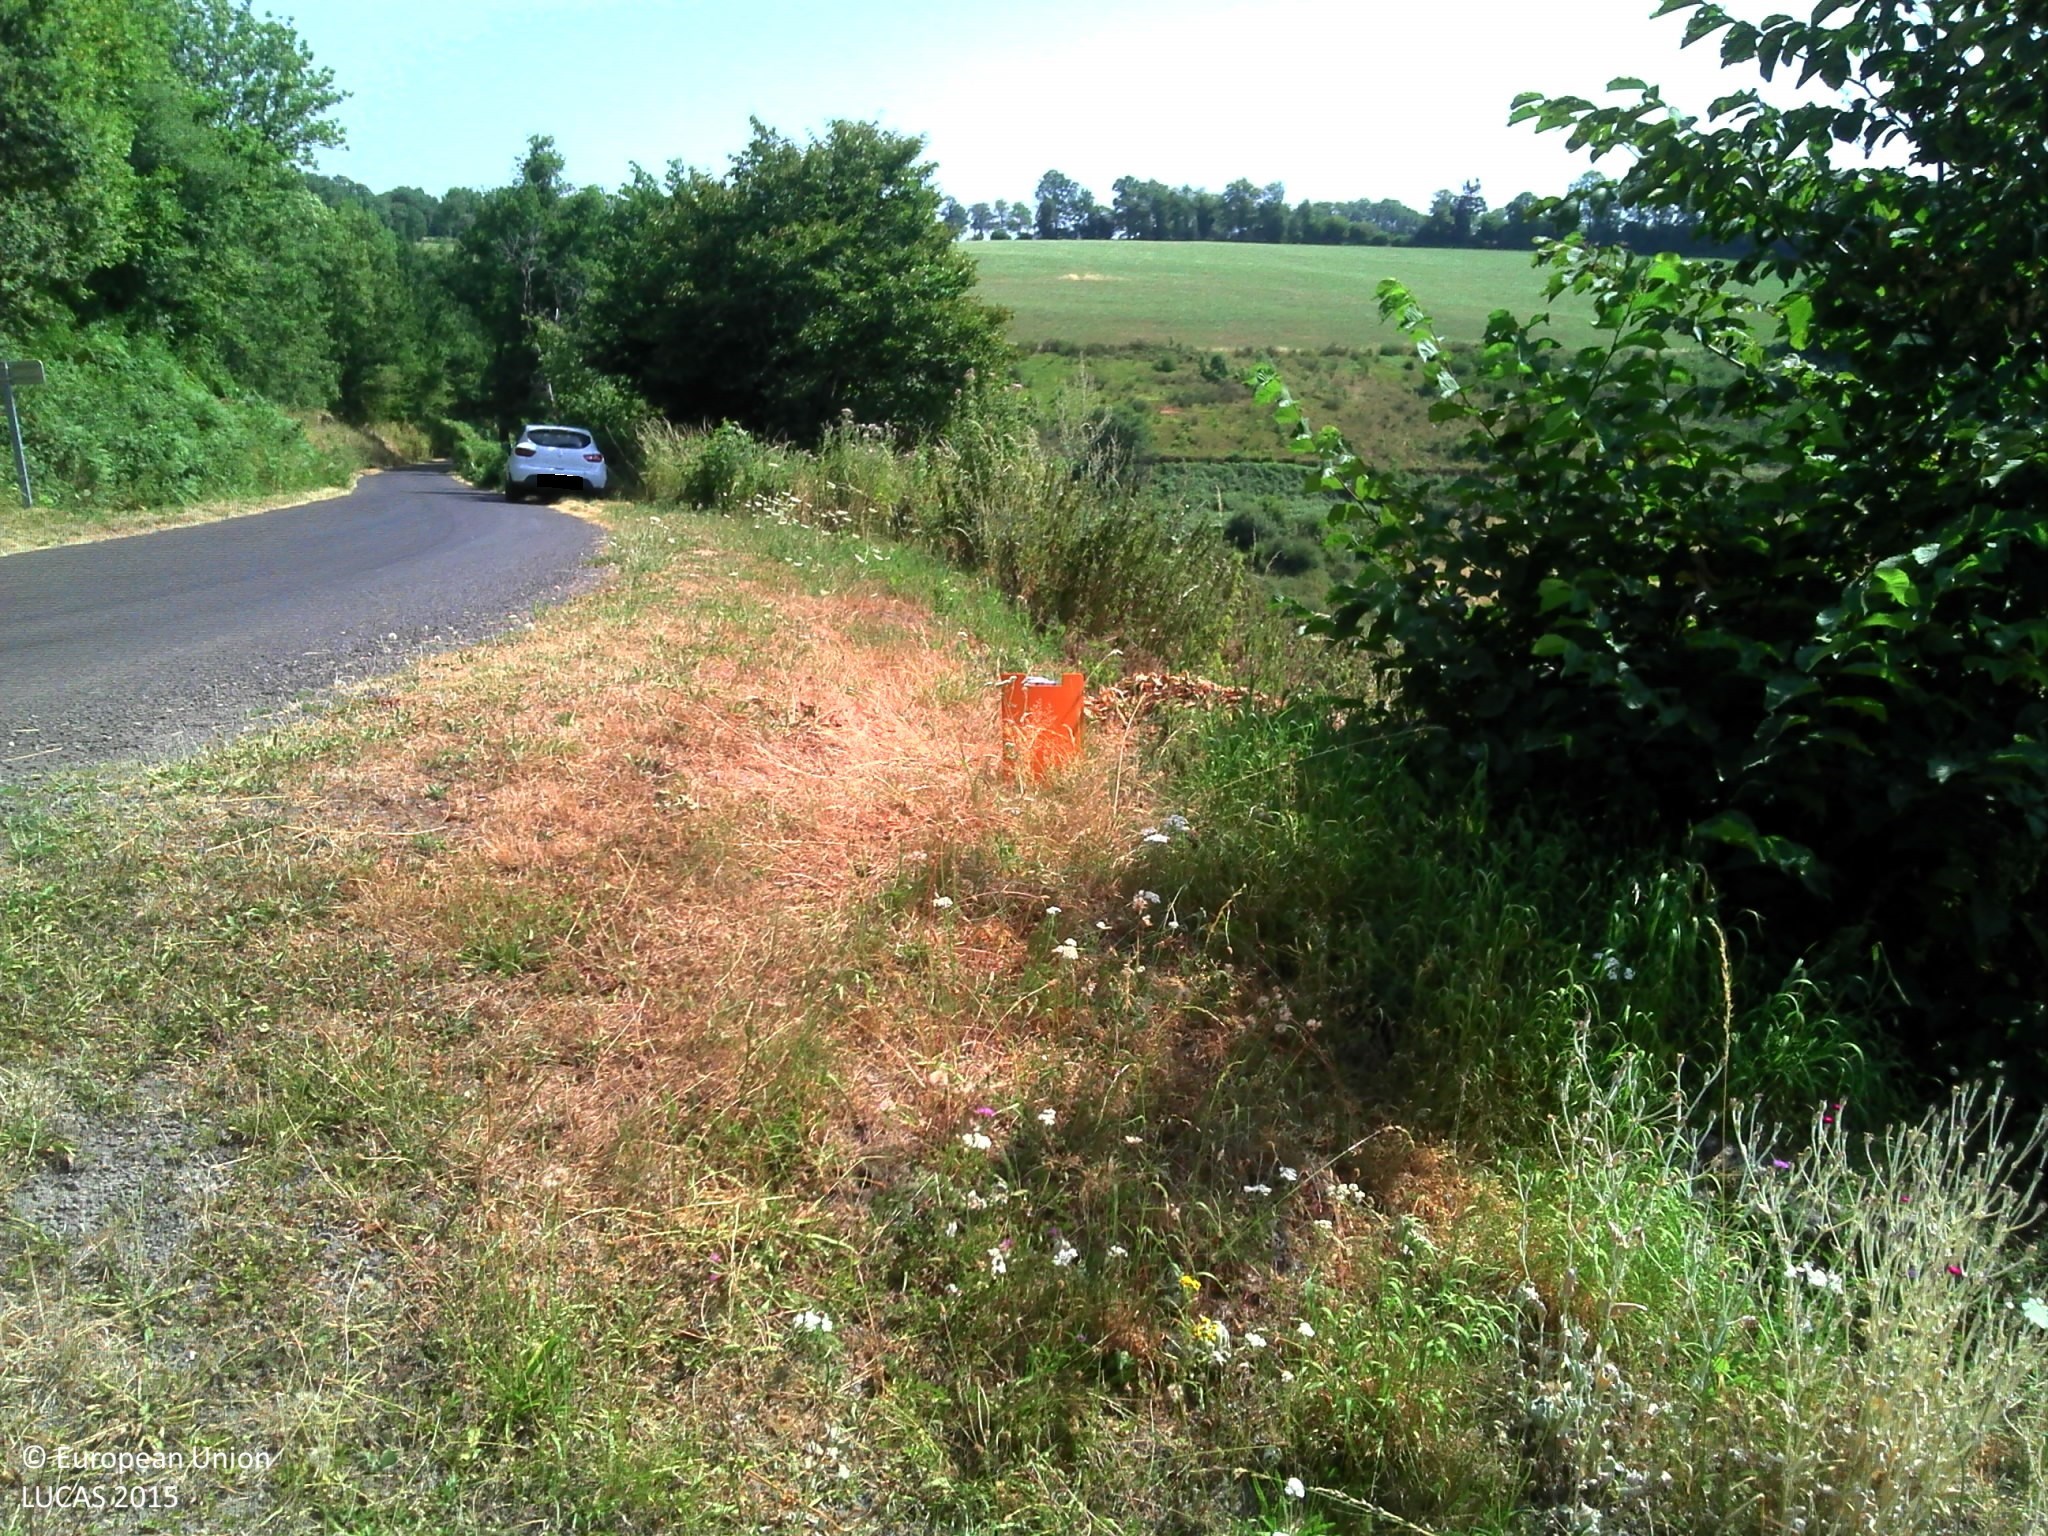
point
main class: Grassland
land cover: Grassland without tree/shrub cover
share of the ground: > 75 %
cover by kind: herbaceous plants 100 %
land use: Road transport
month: July
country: FR
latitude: 45.1187
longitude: 2.3594
